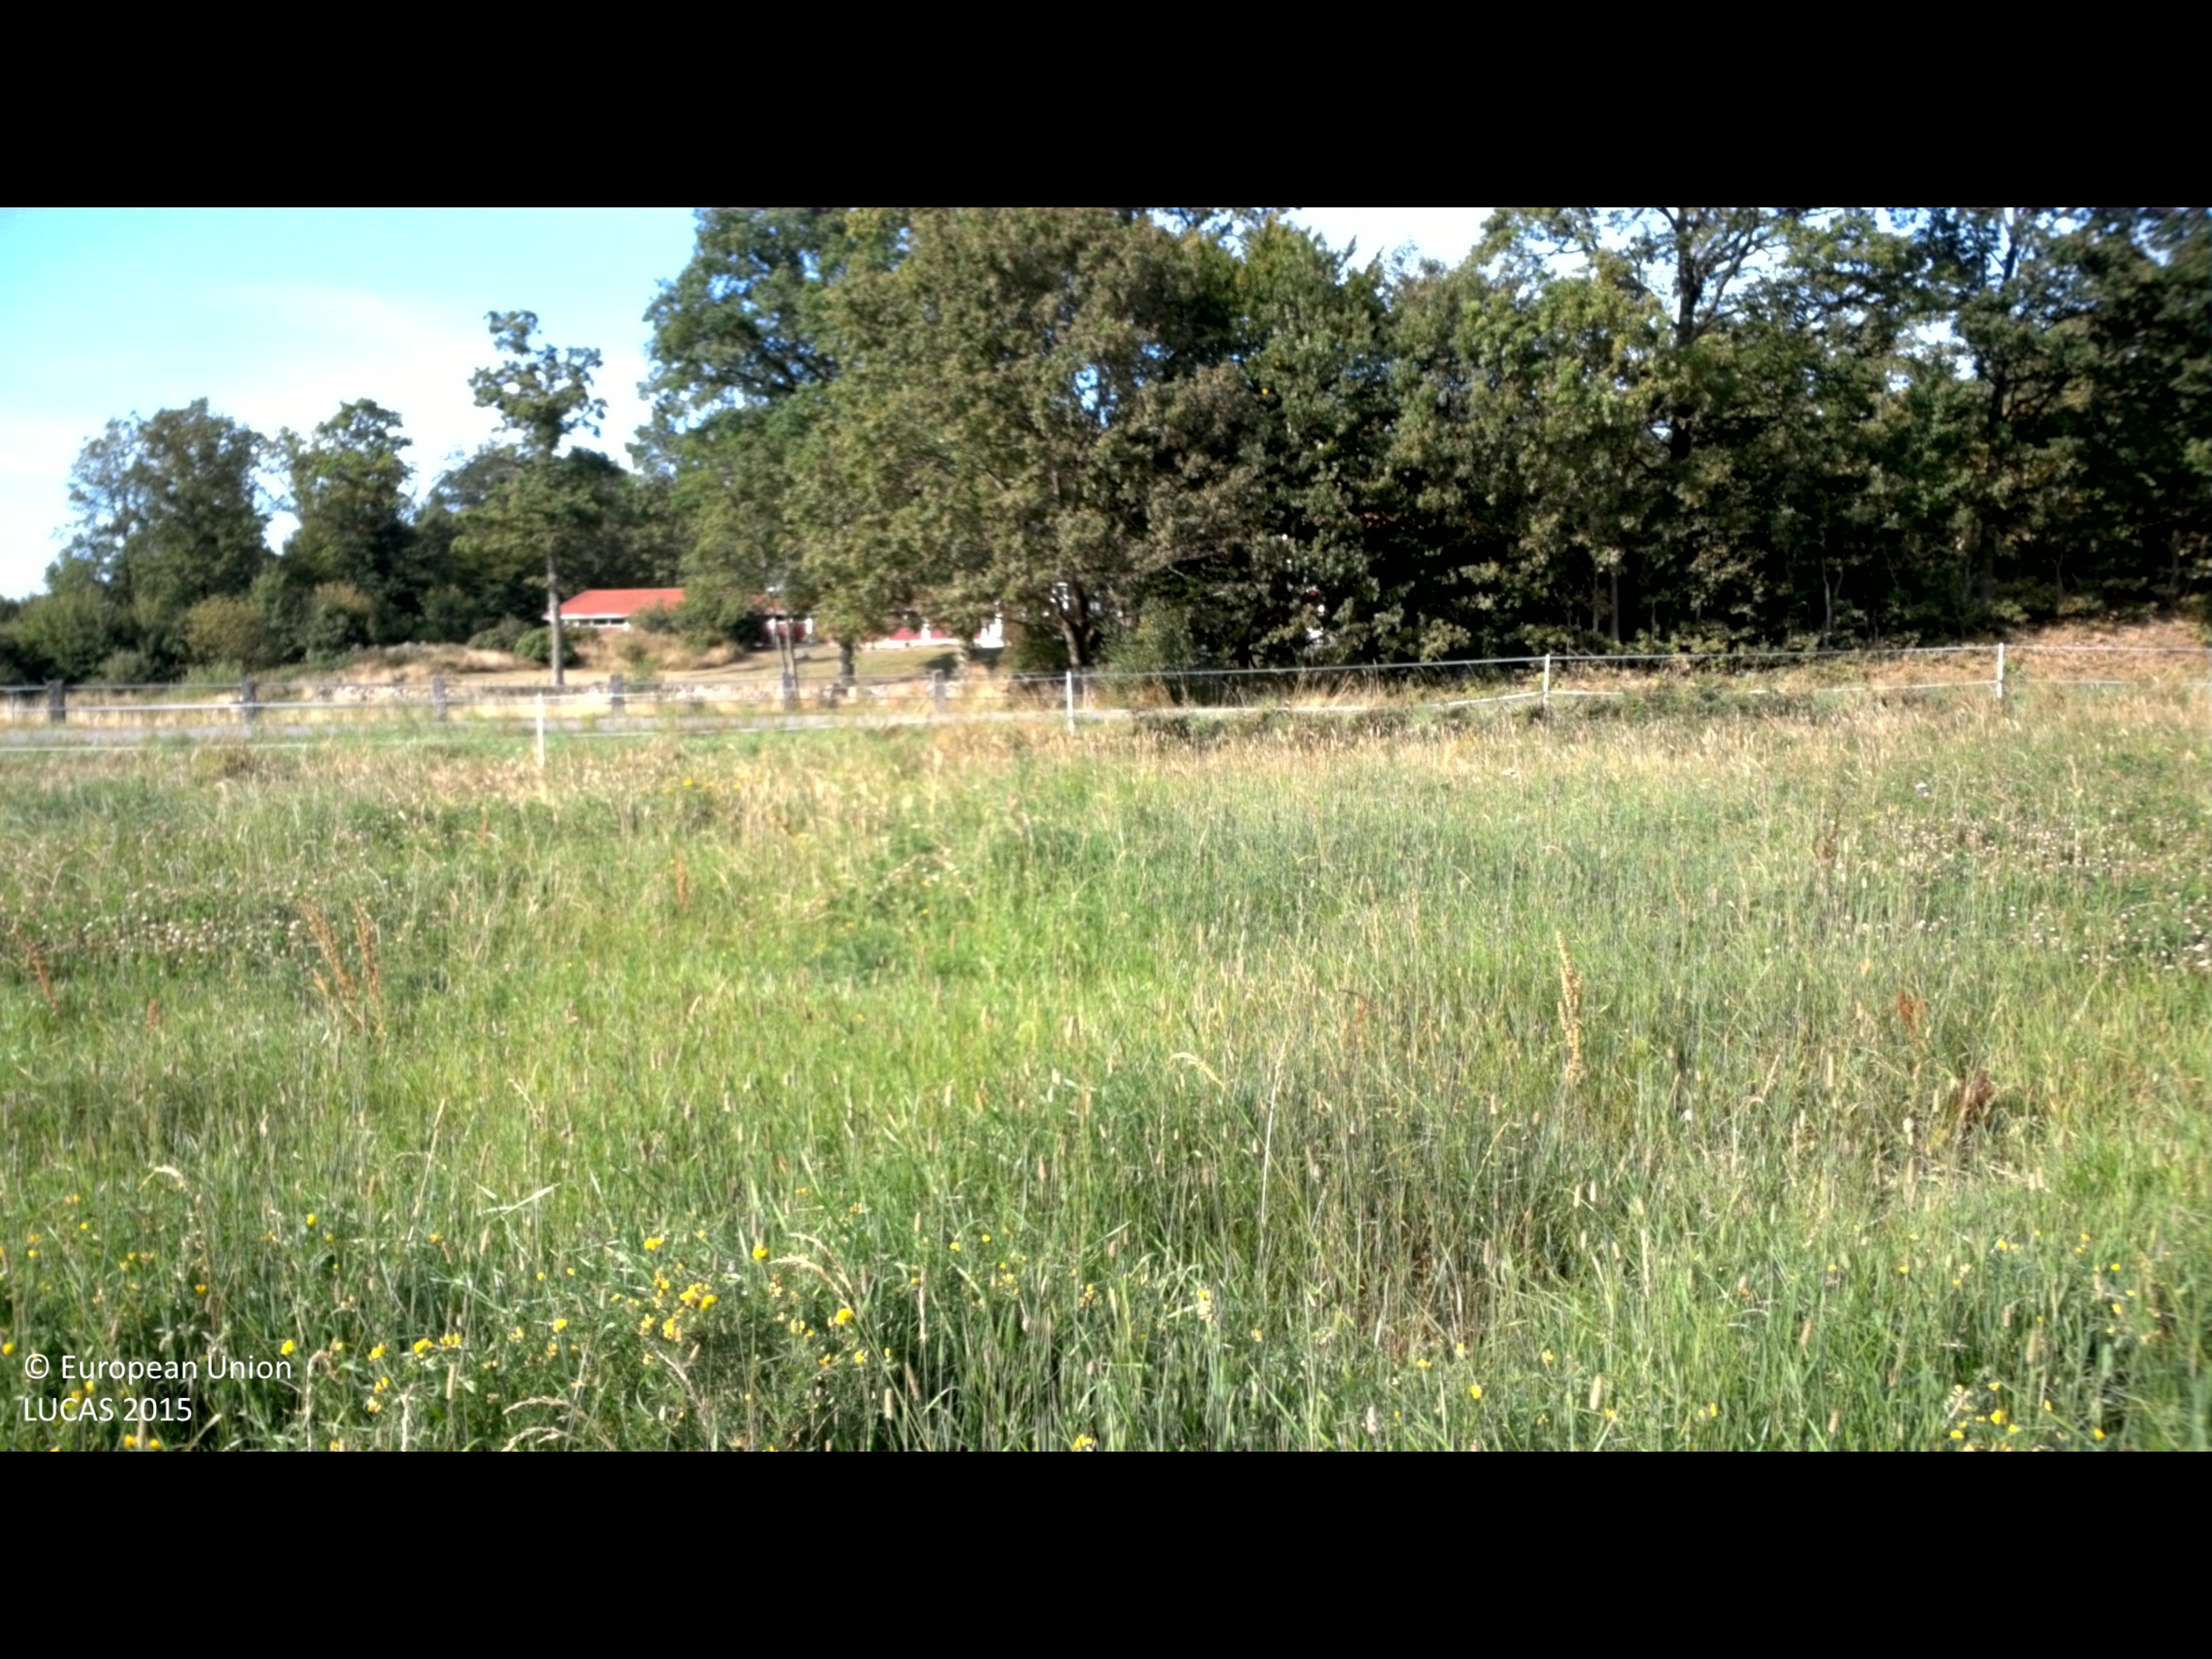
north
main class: Grassland
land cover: Grassland without tree/shrub cover
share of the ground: > 75 %
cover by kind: herbaceous plants 100 %
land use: Agriculture (excluding fallow land and kitchen gardens)
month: August
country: SE
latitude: 56.1923
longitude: 14.6877
